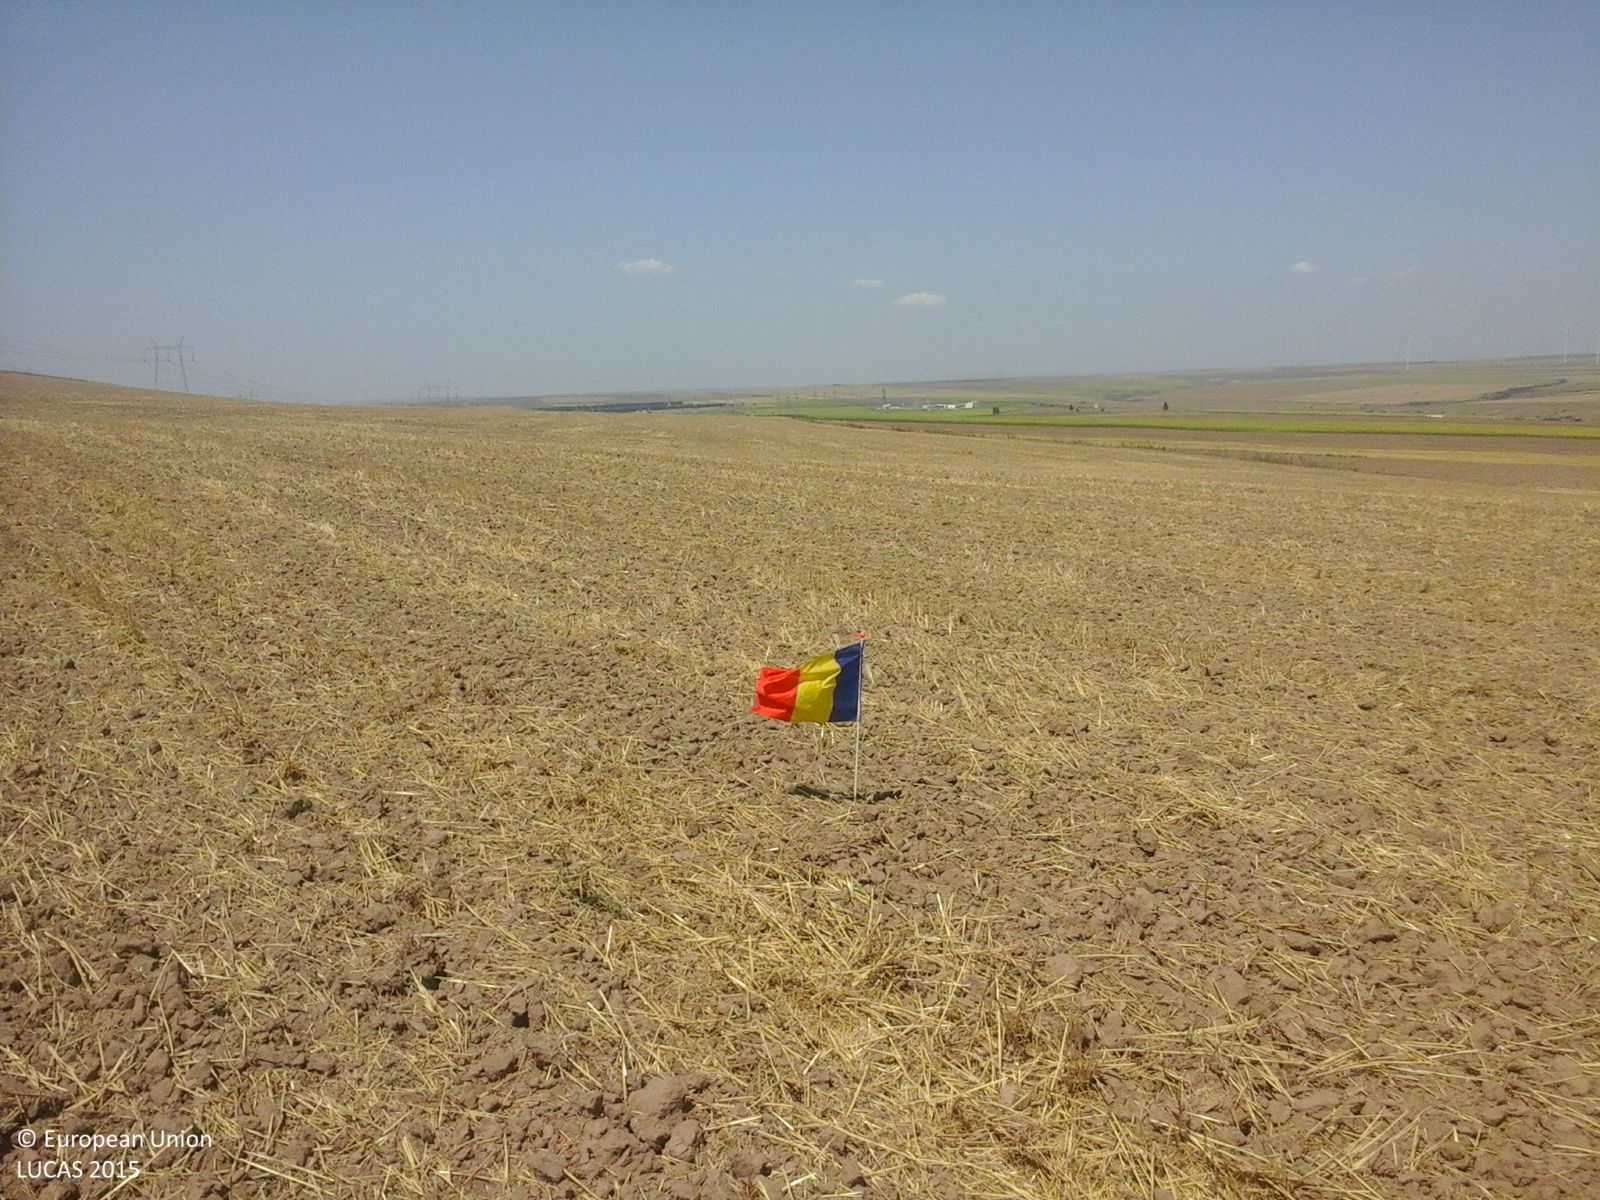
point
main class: Cropland
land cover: Common wheat
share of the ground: 10 - 25 %
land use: Agriculture (excluding fallow land and kitchen gardens)
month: August
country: RO
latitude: 44.5331
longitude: 28.1974
